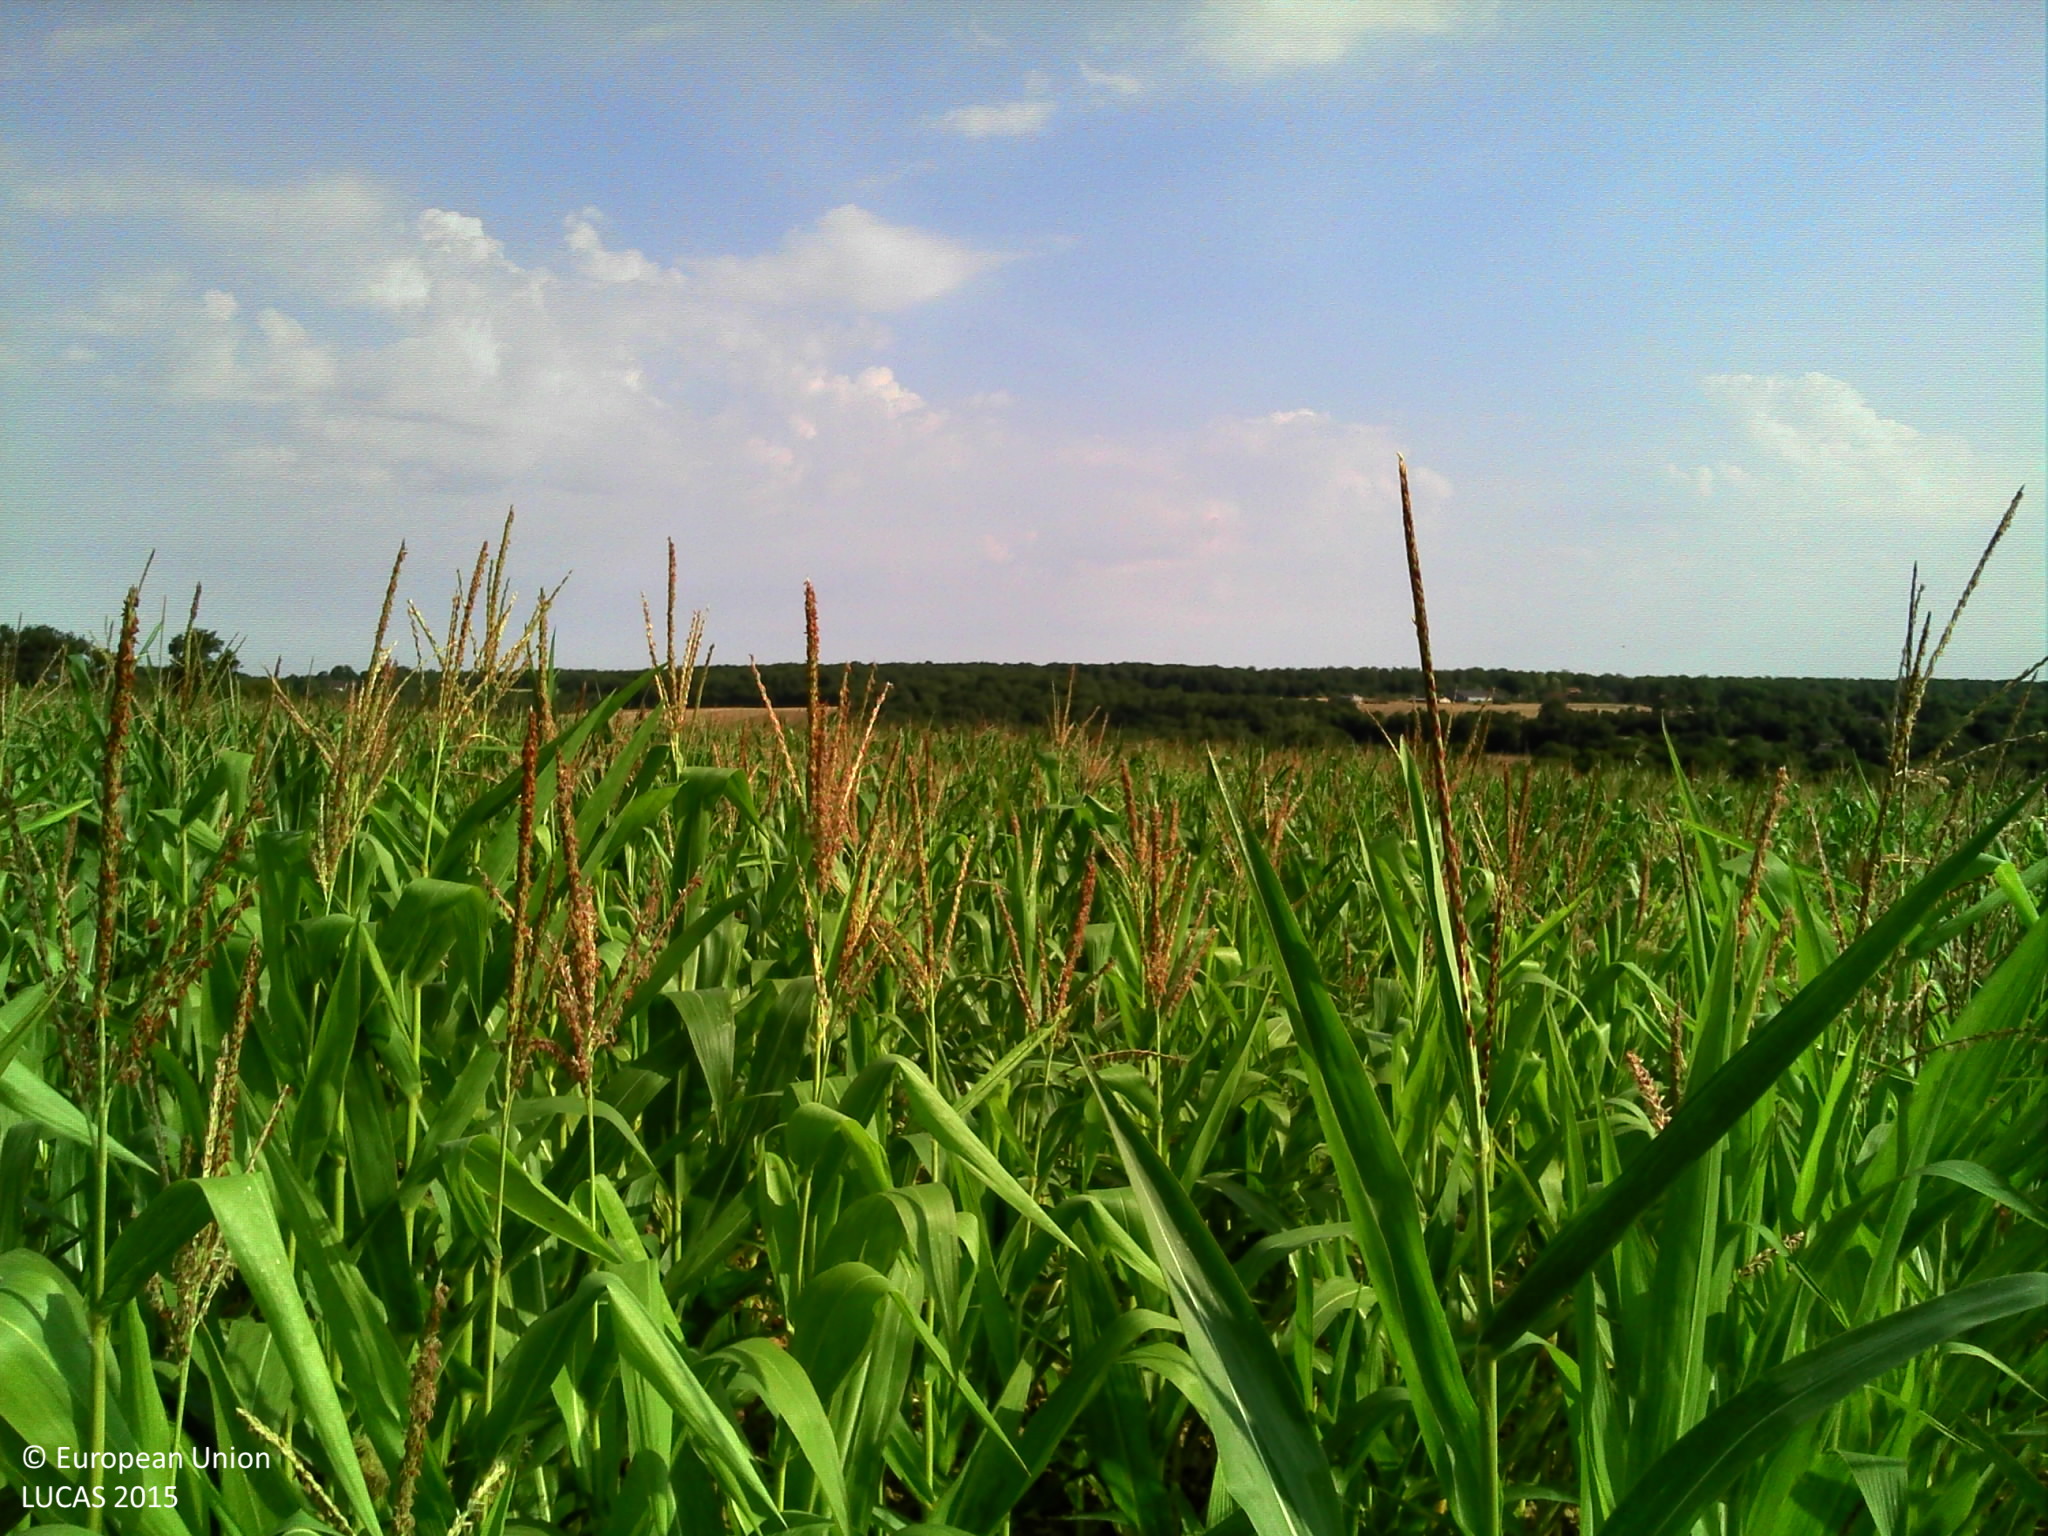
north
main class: Cropland
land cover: Maize
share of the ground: > 75 %
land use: Agriculture (excluding fallow land and kitchen gardens)
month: August
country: FR
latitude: 47.7039
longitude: 3.1578
